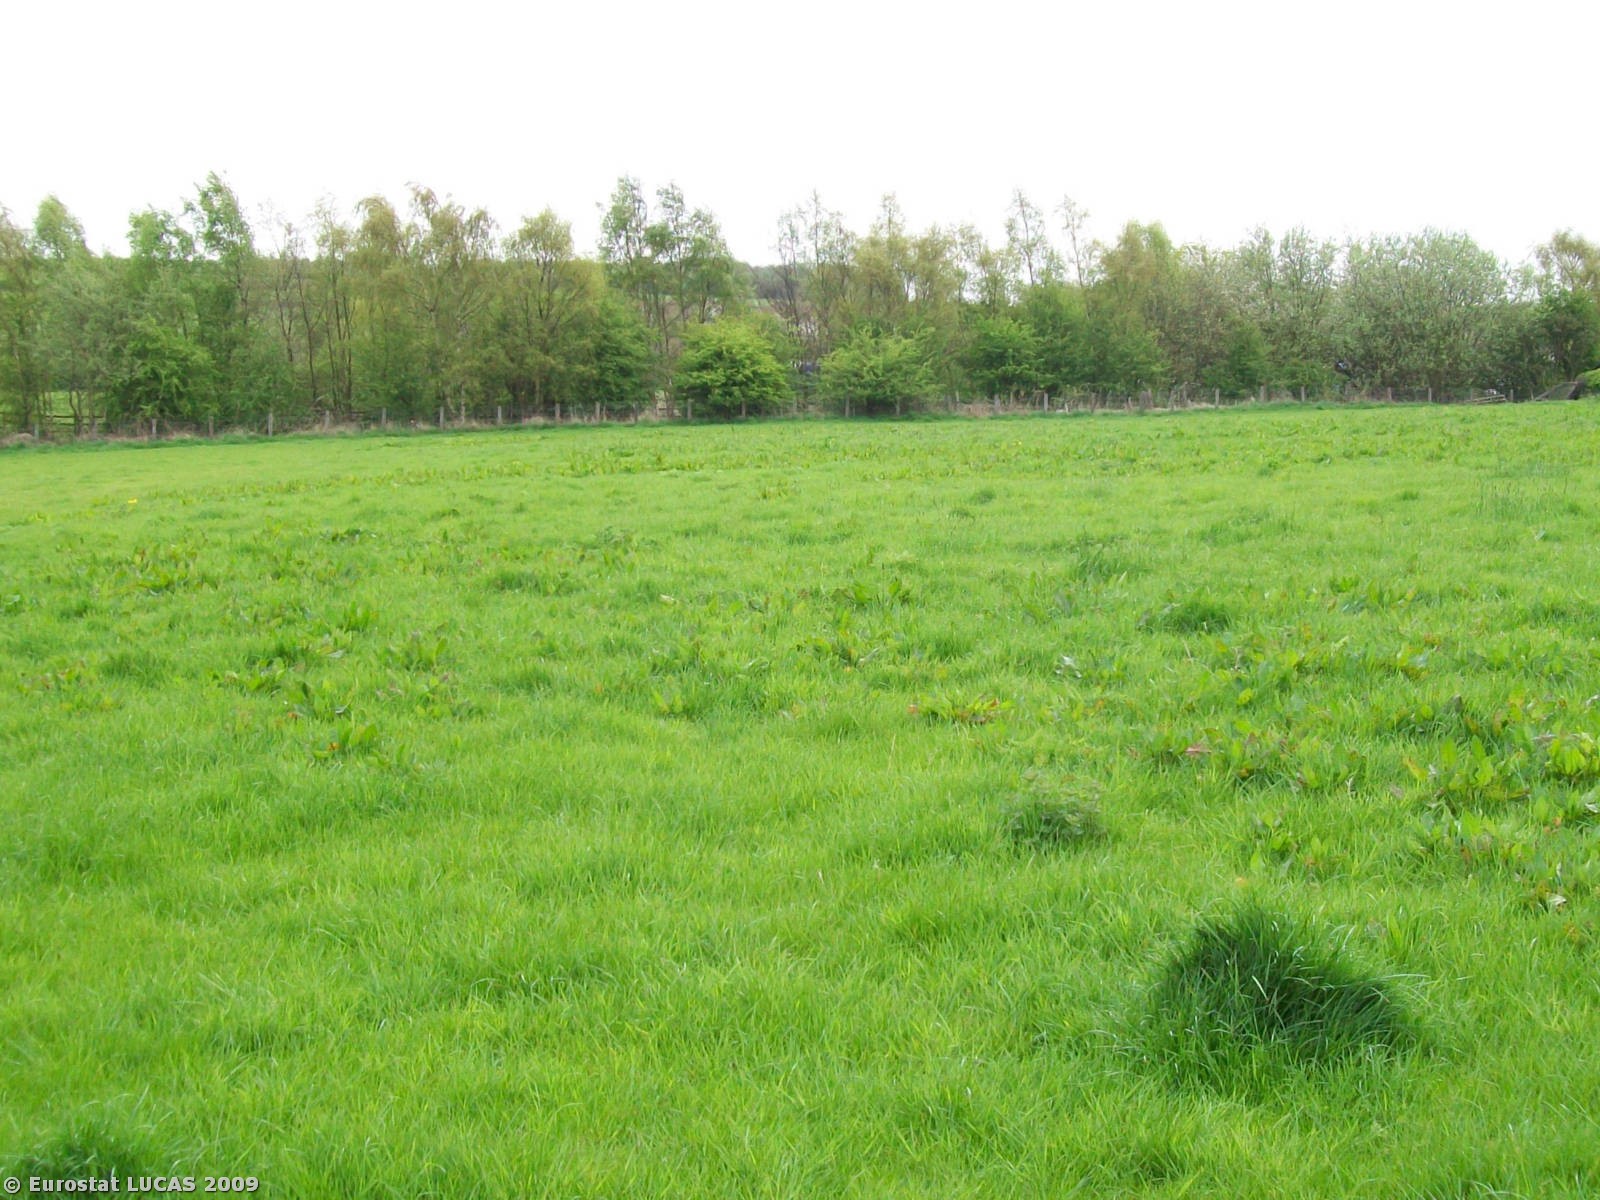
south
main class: Grassland
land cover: Grassland without tree/shrub cover
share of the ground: > 75 %
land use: Agriculture (excluding fallow land and kitchen gardens)
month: April
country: GB
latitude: 53.0227
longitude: -1.4246
